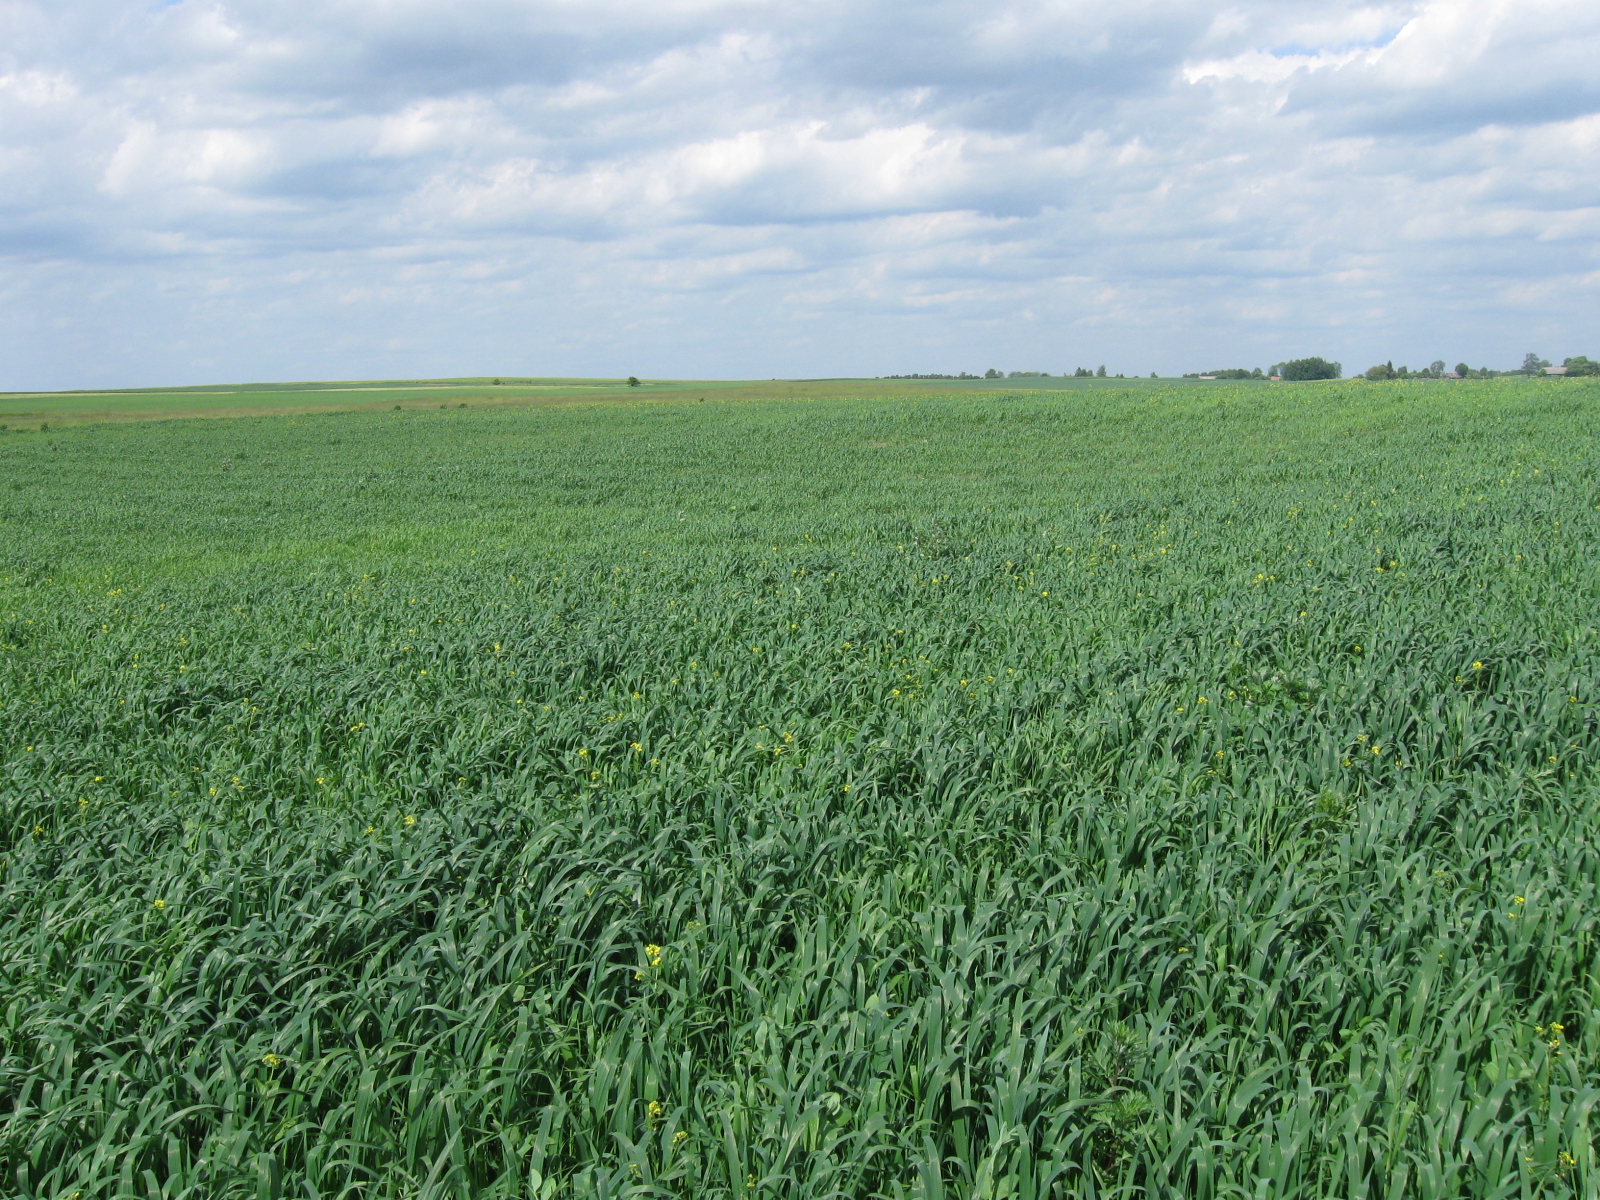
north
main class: Cropland
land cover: Oats
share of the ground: > 75 %
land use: Agriculture (excluding fallow land and kitchen gardens)
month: June
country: LT
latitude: 54.3595
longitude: 23.7995
